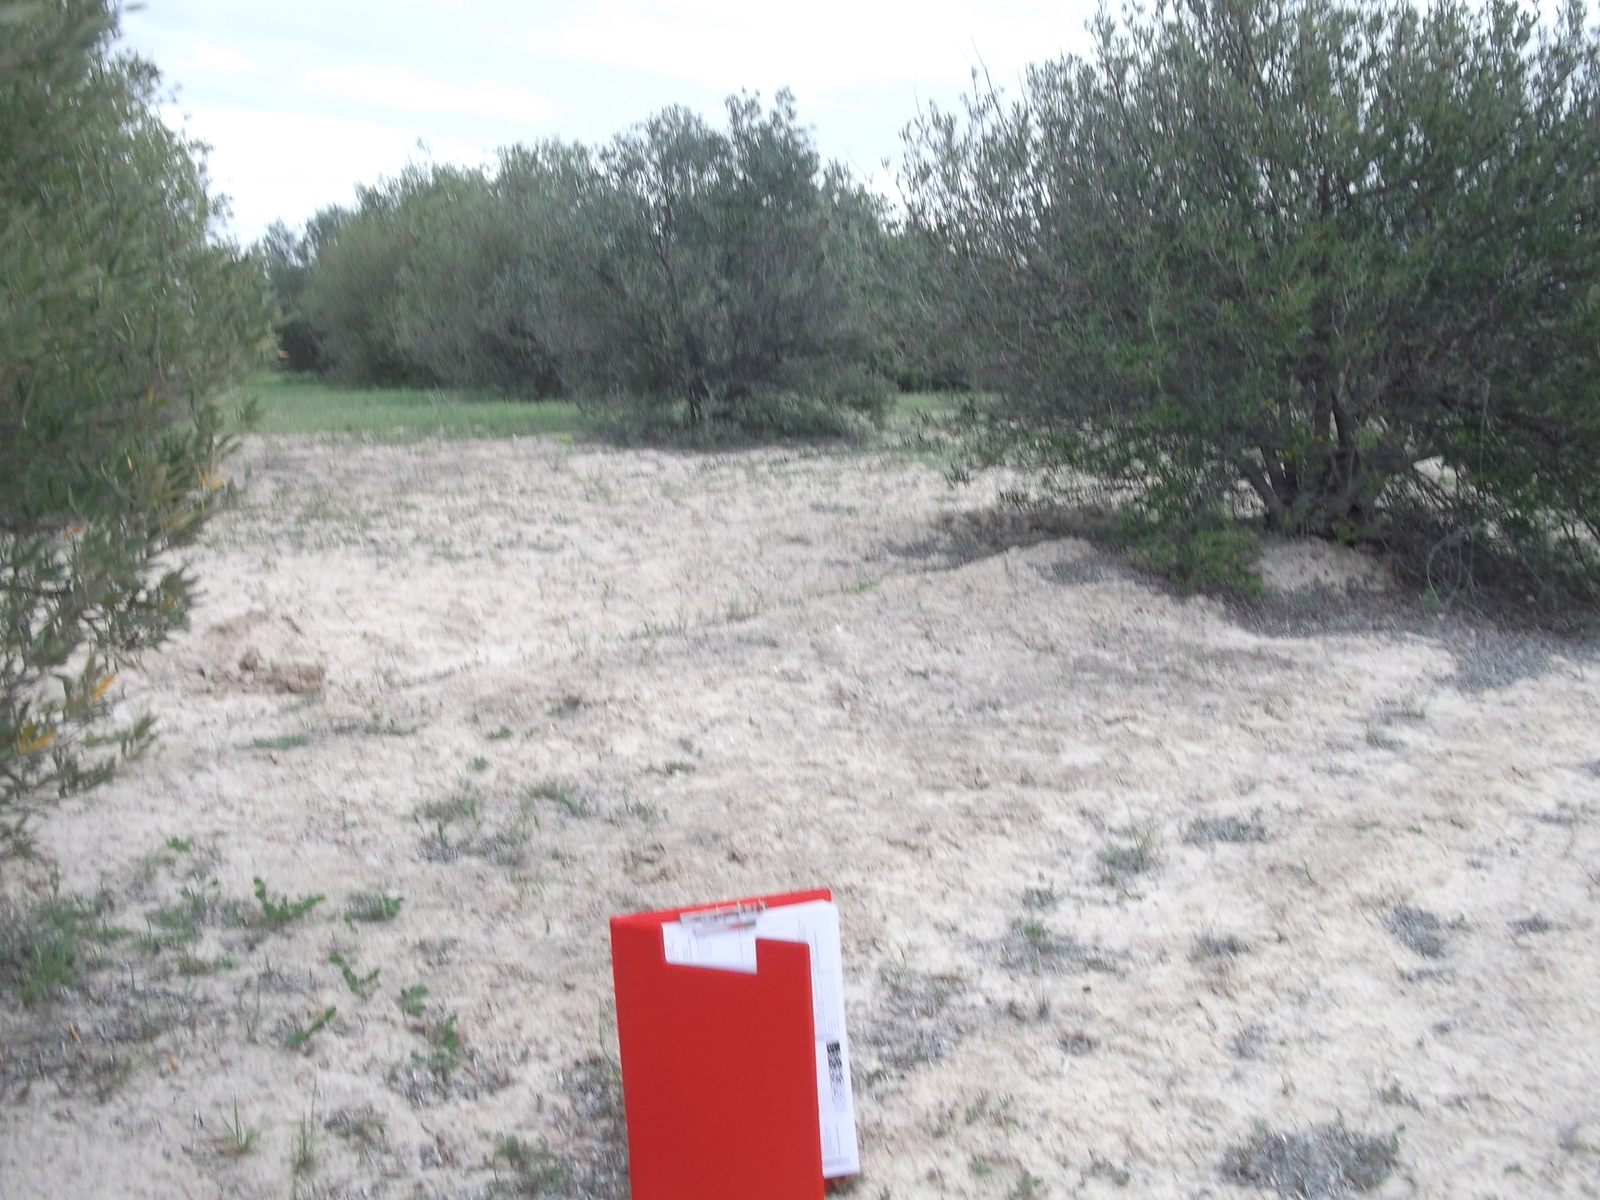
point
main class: Cropland
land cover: Olive groves
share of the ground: 25 - 50 %
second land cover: Other bare soil
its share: > 75 %
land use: Agriculture (excluding fallow land and kitchen gardens)
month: April
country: ES
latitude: 38.1548
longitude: -1.5714
